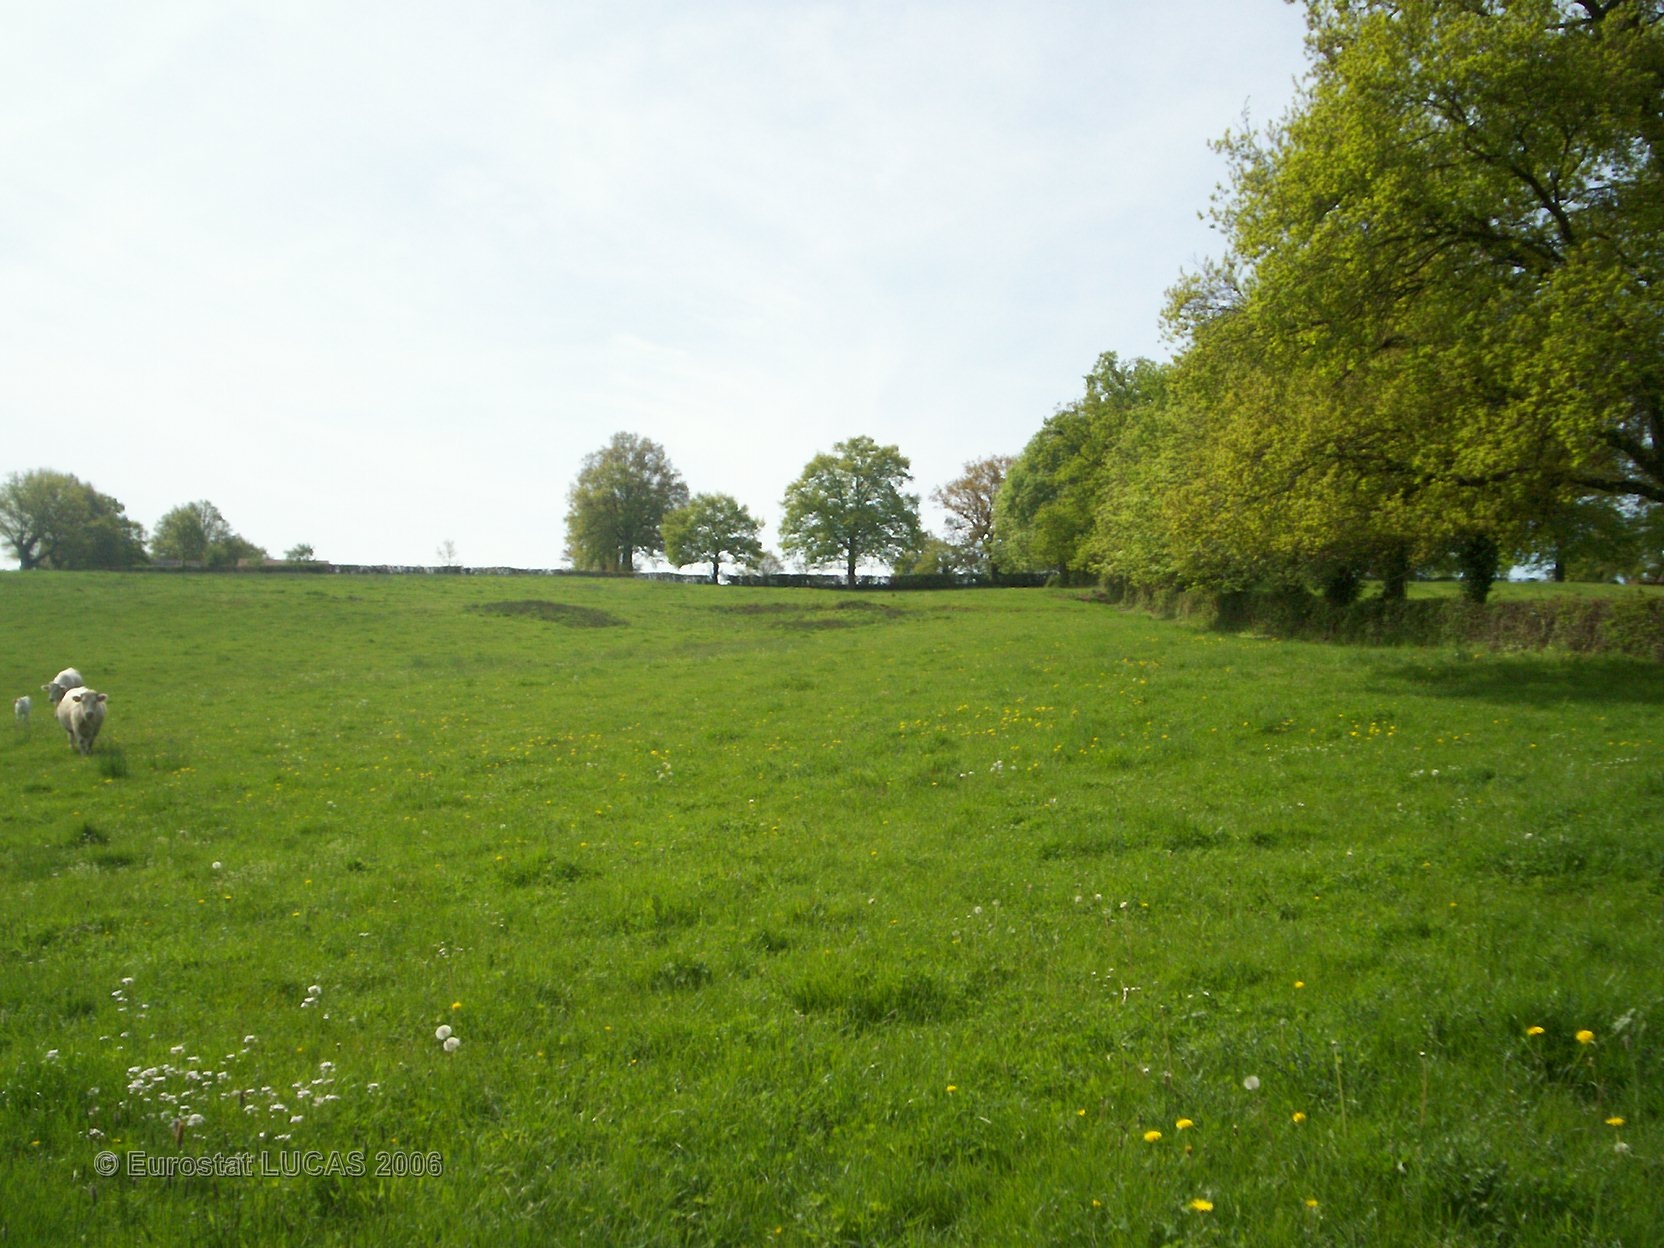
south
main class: Grassland
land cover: Grassland with sparse tree/shrub cover
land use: Agriculture (excluding fallow land and kitchen gardens)
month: May
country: FR
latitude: 46.3663
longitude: 3.1479
